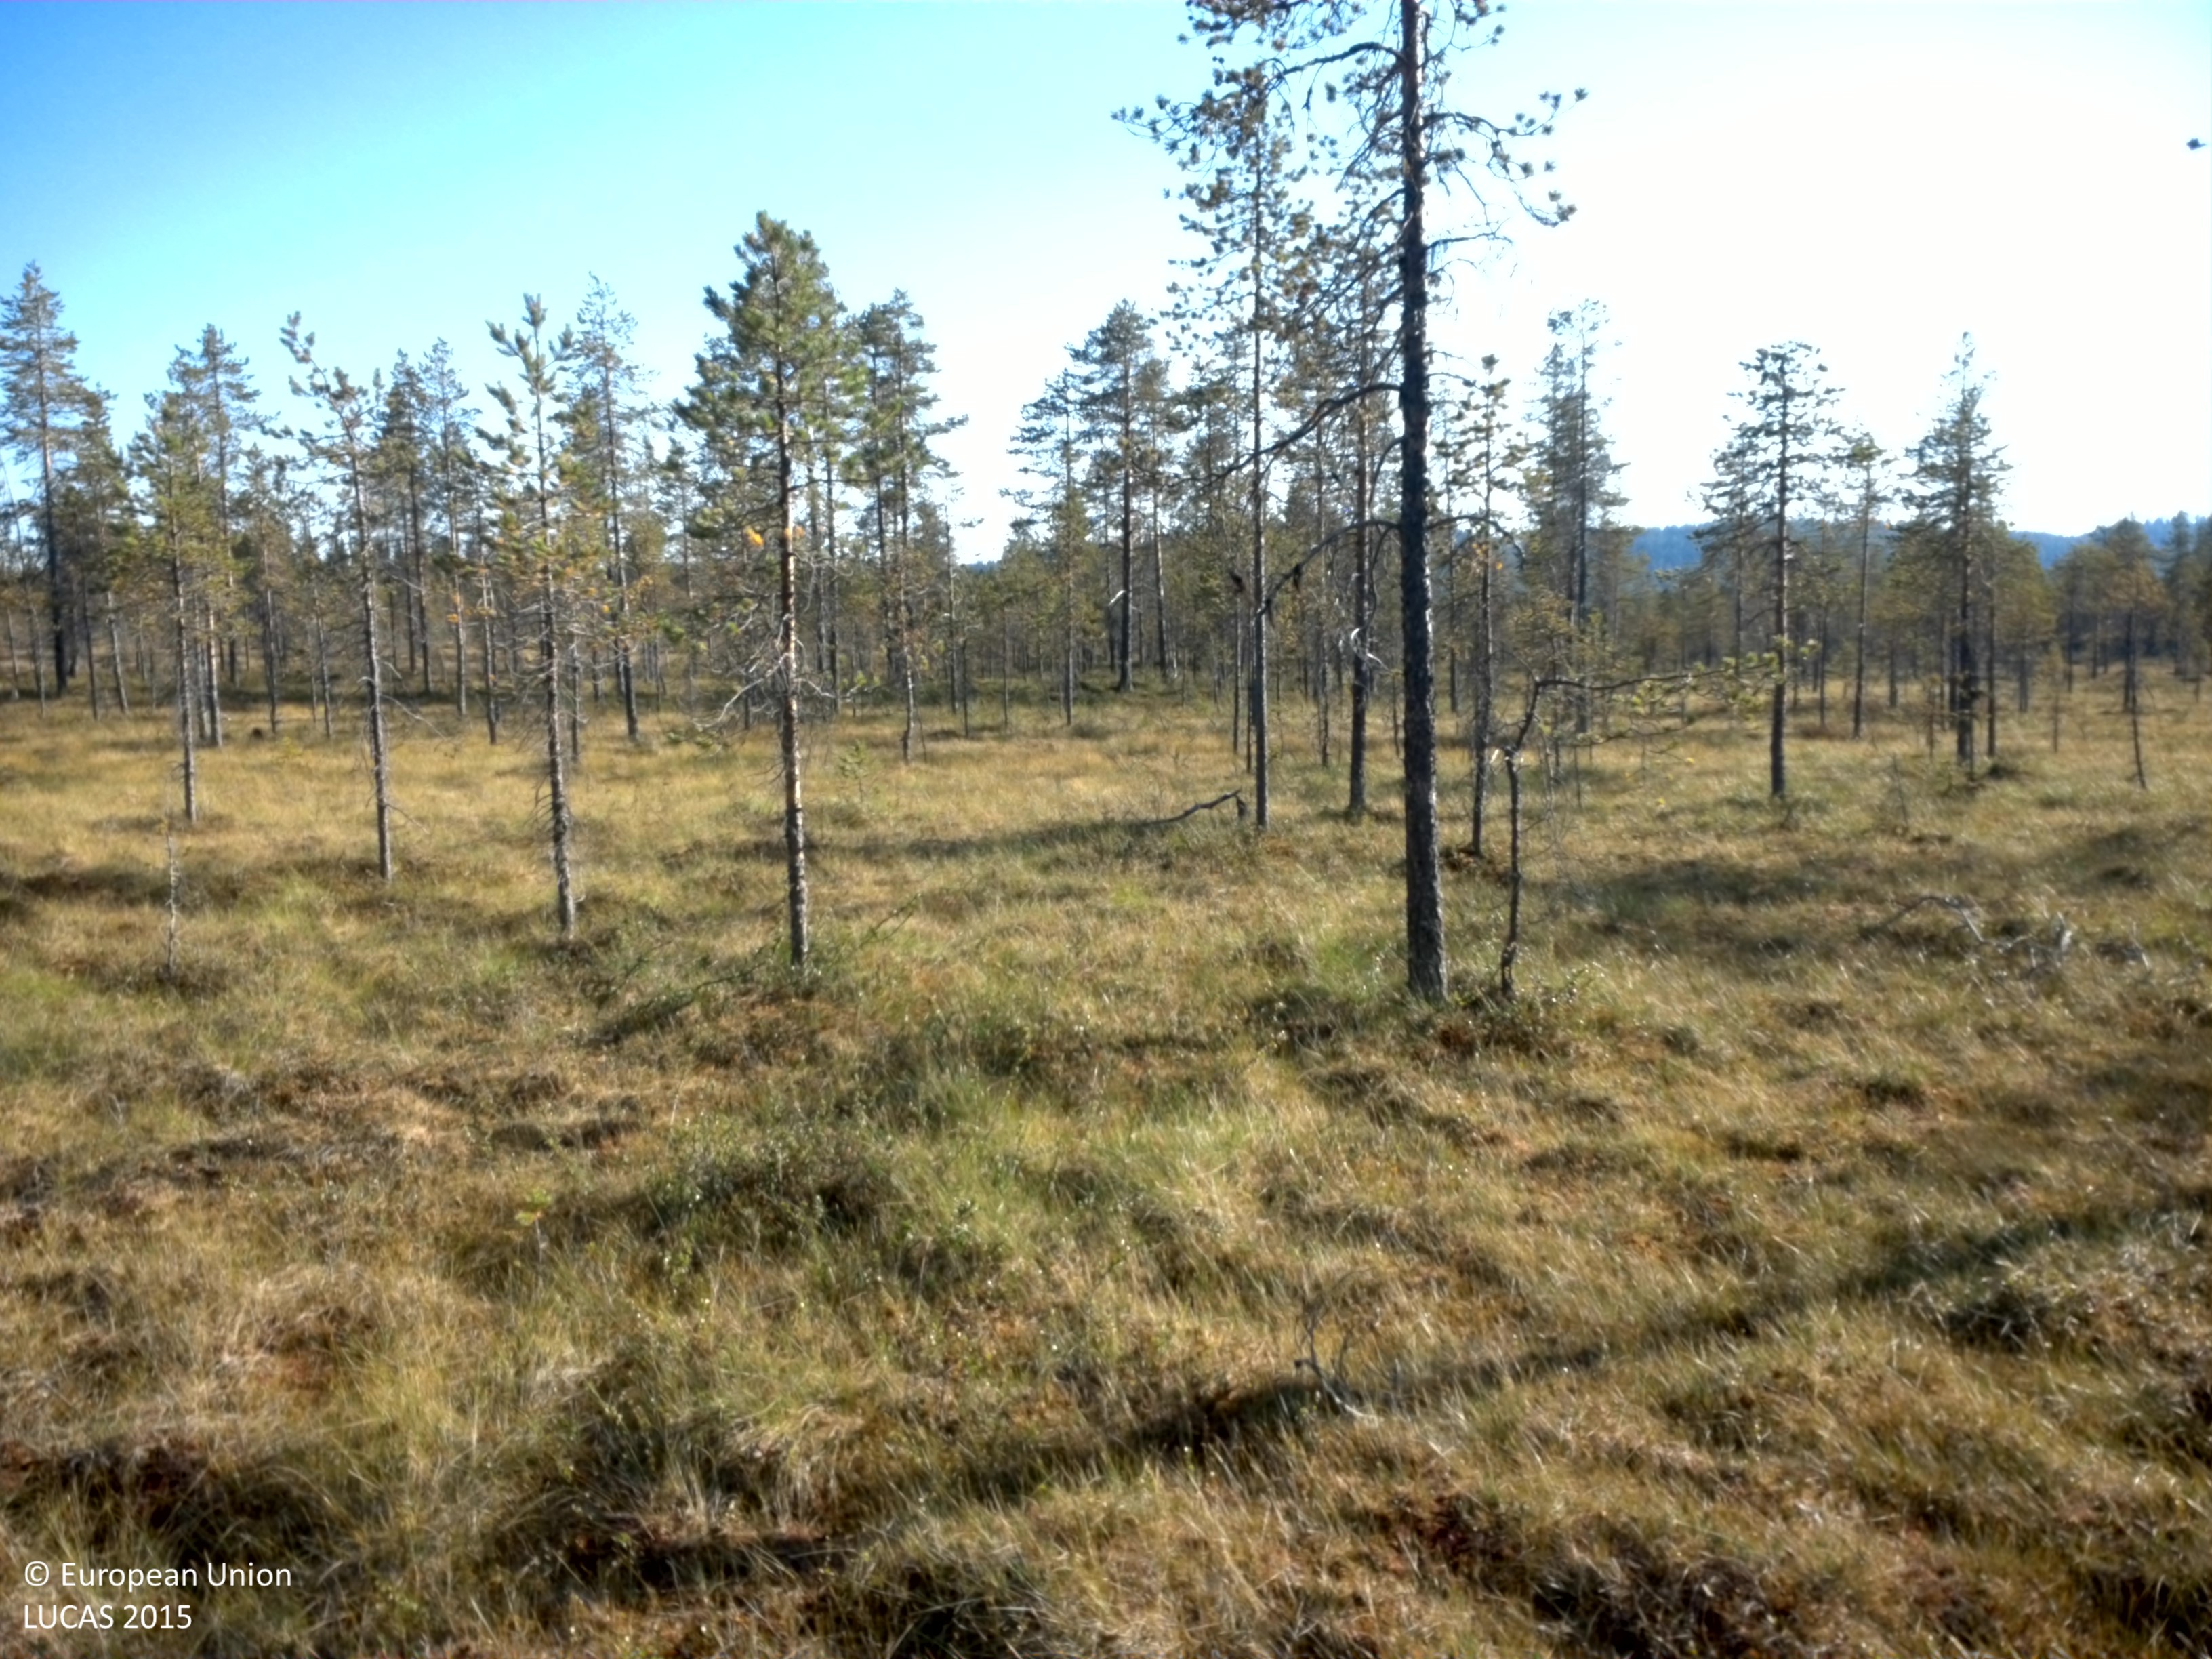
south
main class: Woodland
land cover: Pine dominated coniferous woodland
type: mire and swamp forests
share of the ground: 10 - 25 %
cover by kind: herbaceous plants 35 %, lichens and mosses 35 %, shrubs 20 %, coniferous forest trees 10 %
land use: Semi-natural and natural areas not in use
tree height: > 5 m
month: August
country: SE
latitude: 64.7099
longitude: 16.7007
